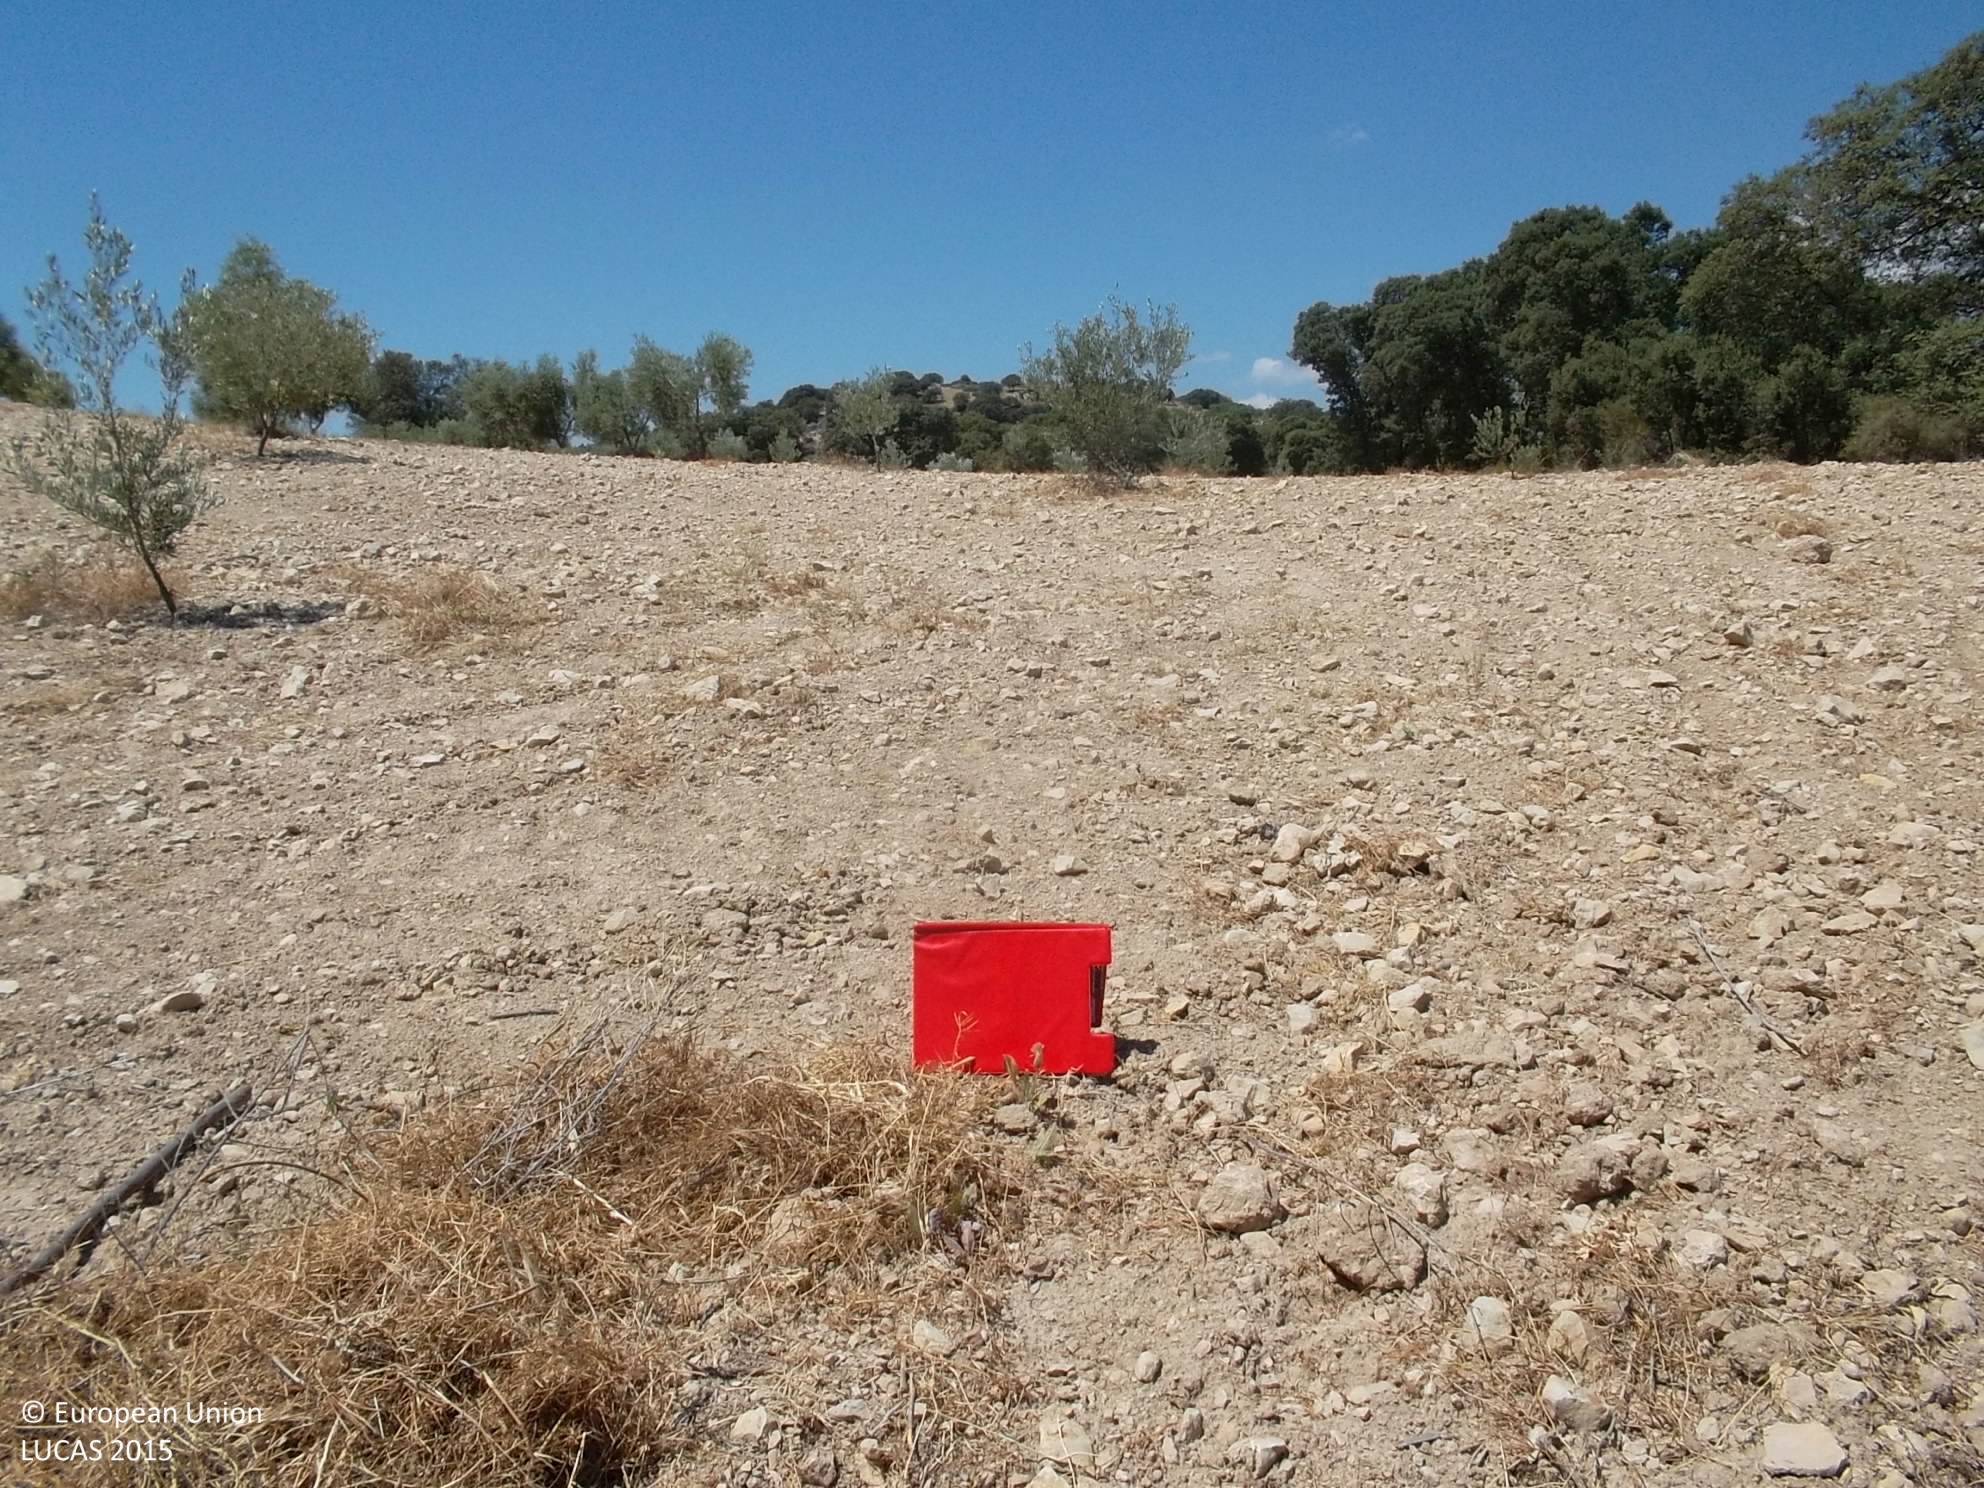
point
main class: Cropland
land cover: Olive groves
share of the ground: 10 - 25 %
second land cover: Other bare soil
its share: > 75 %
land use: Agriculture (excluding fallow land and kitchen gardens)
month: June
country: ES
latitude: 37.6659
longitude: -3.3378
